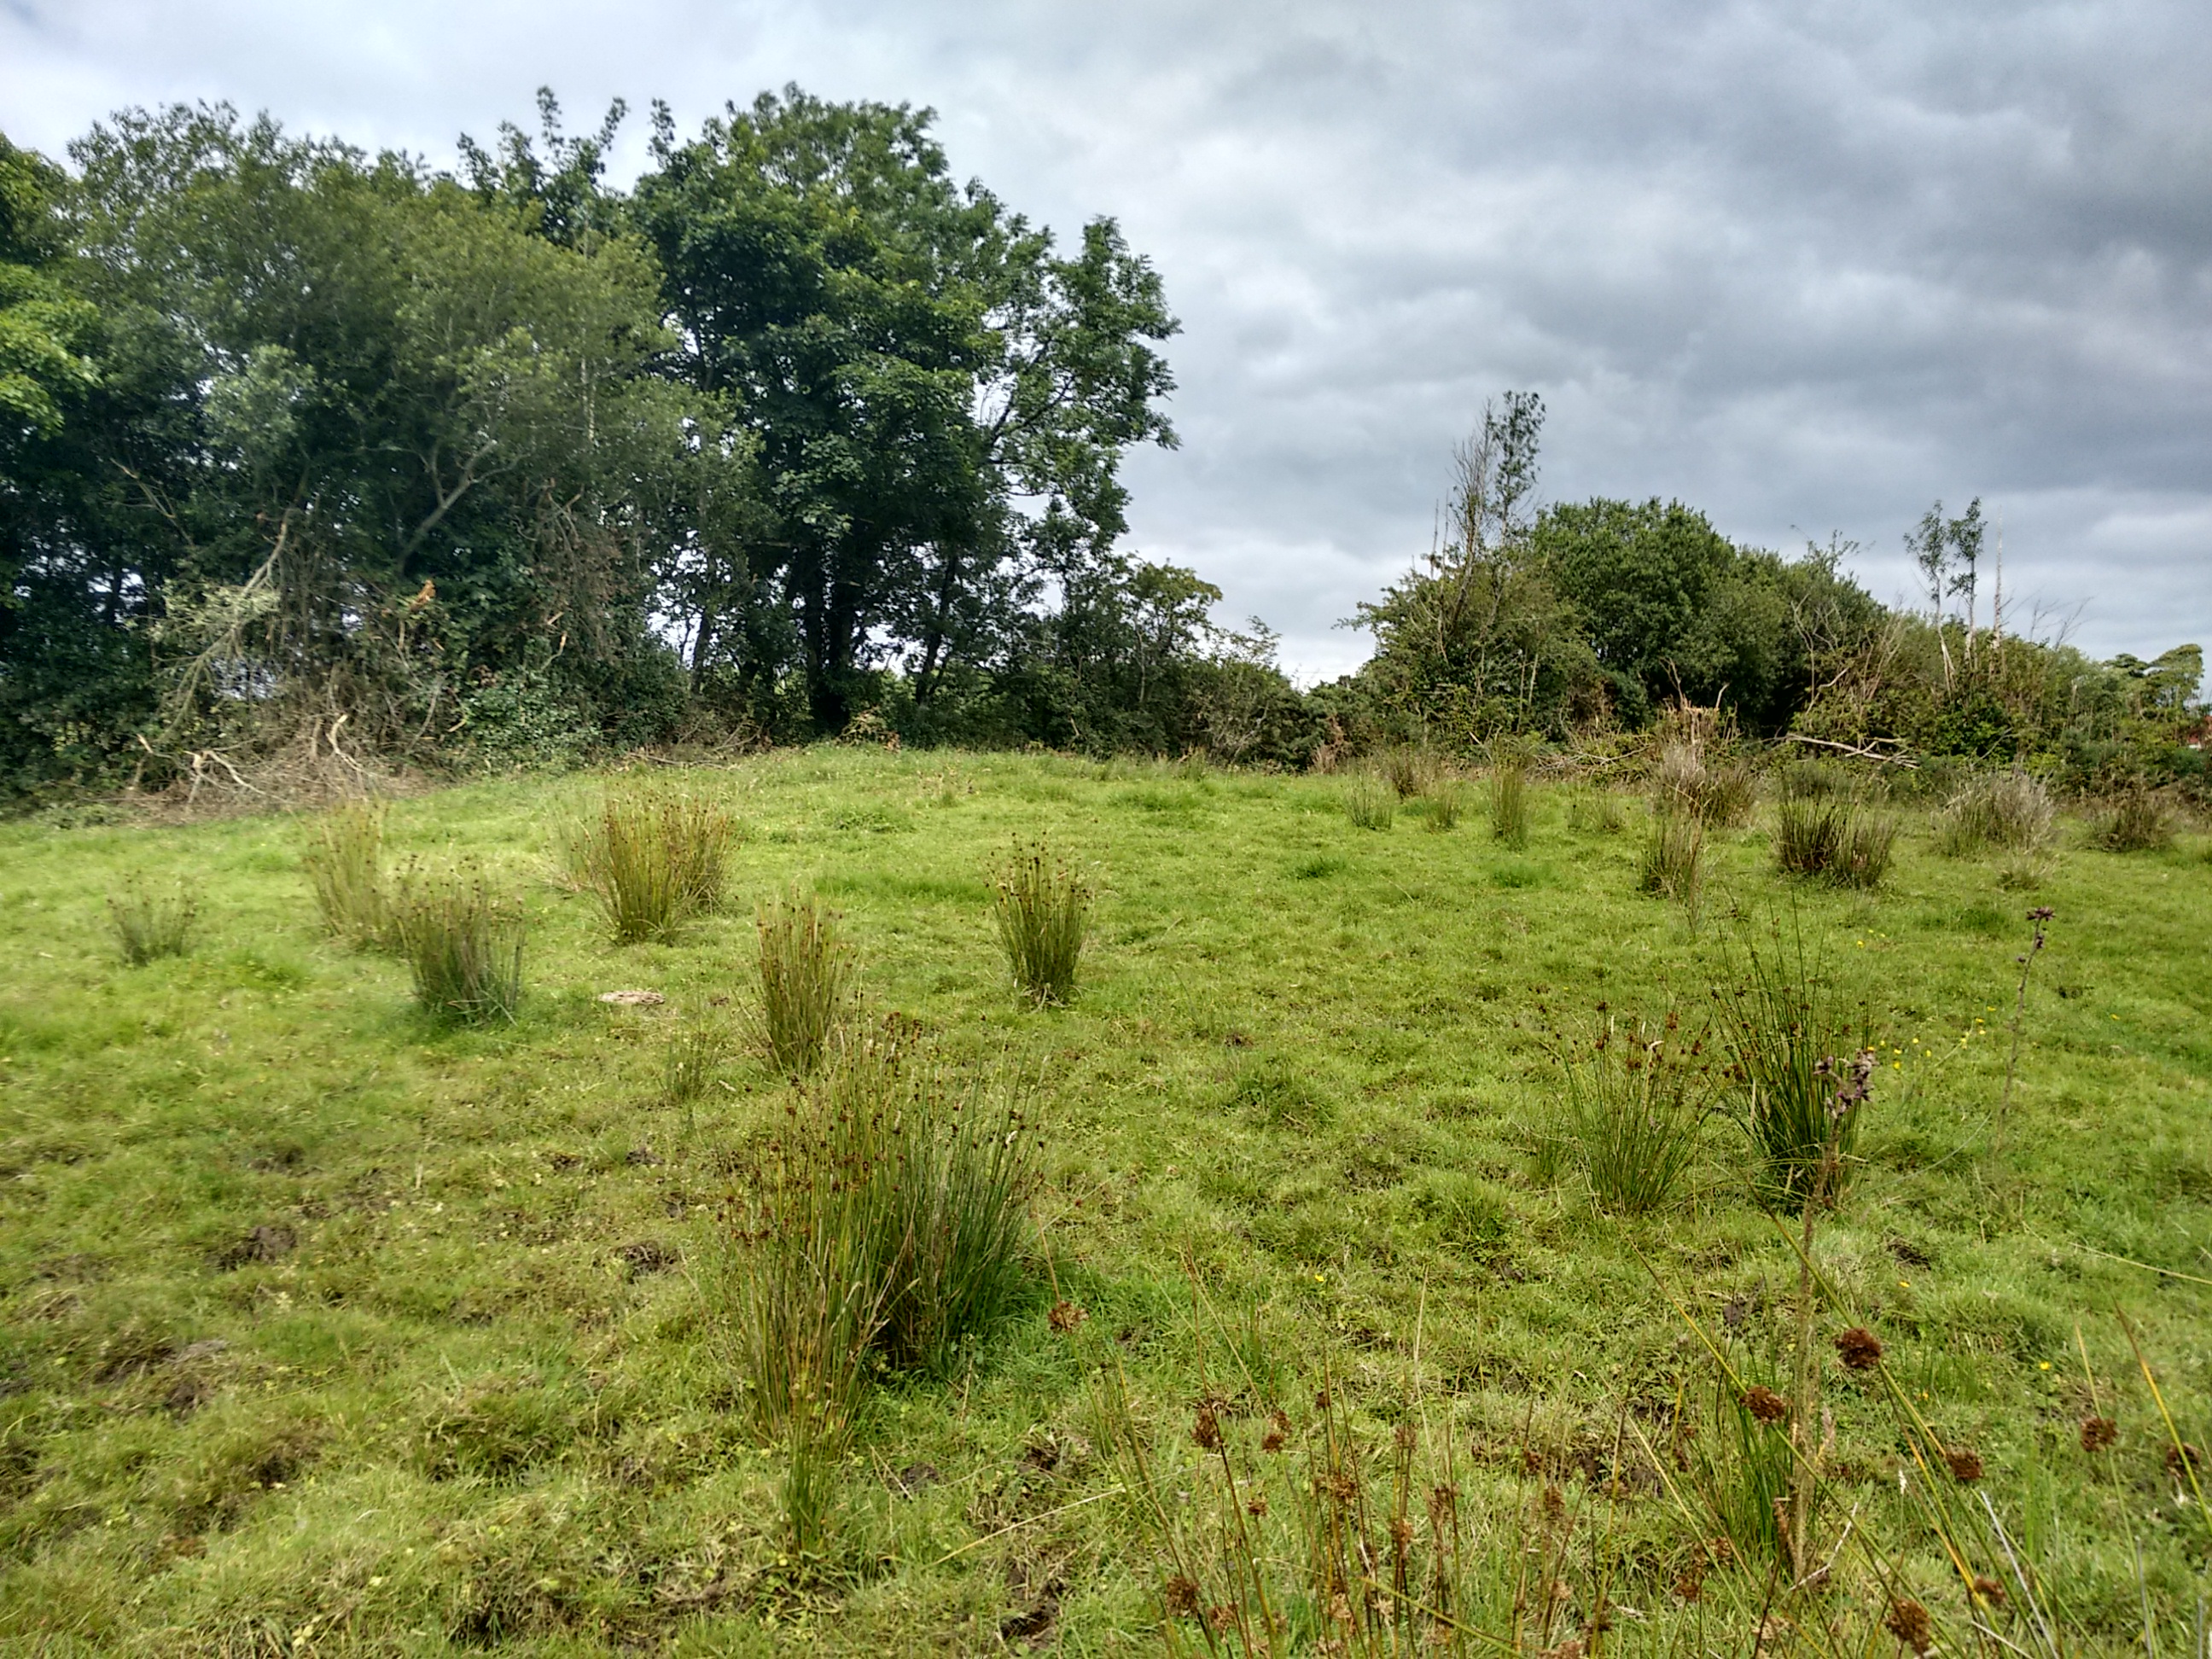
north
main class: Grassland
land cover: Grassland without tree/shrub cover
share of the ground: > 75 %
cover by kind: herbaceous plants 100 %
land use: Agriculture (excluding fallow land and kitchen gardens)
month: August
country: GB
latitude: 54.4987
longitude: -6.9214
